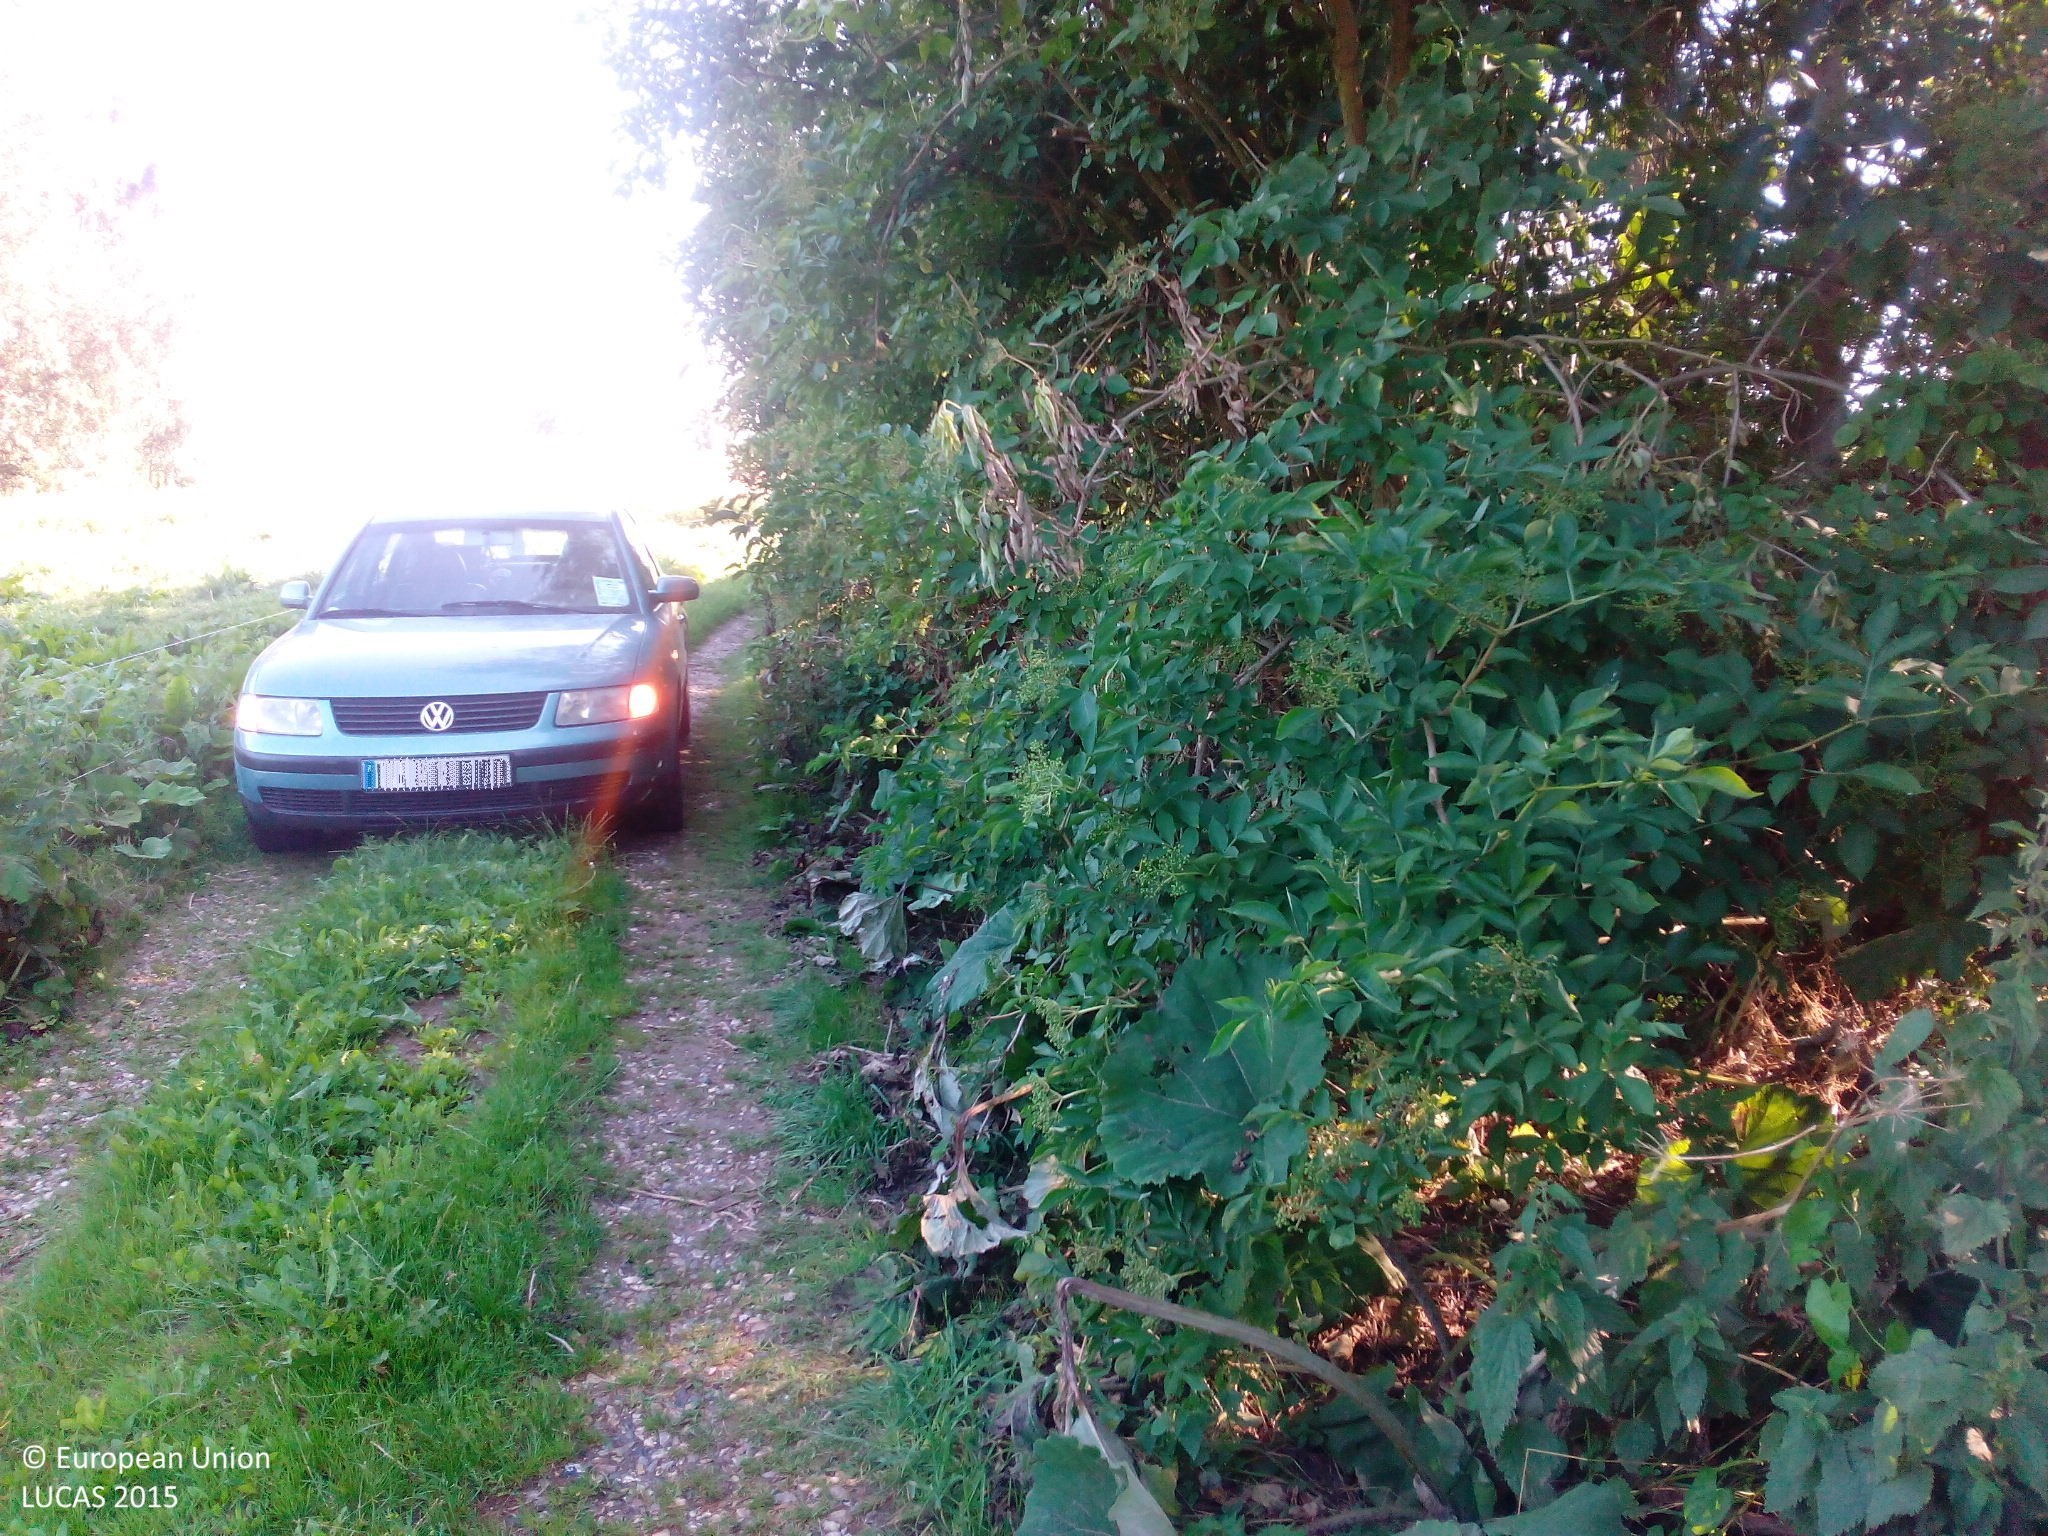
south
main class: Woodland
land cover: Spruce dominated coniferous woodland
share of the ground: > 75 %
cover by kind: coniferous forest trees 80 %, broadleaved forest trees 20 %
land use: Semi-natural and natural areas not in use
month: August
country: DK
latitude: 55.6358
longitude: 11.7935
